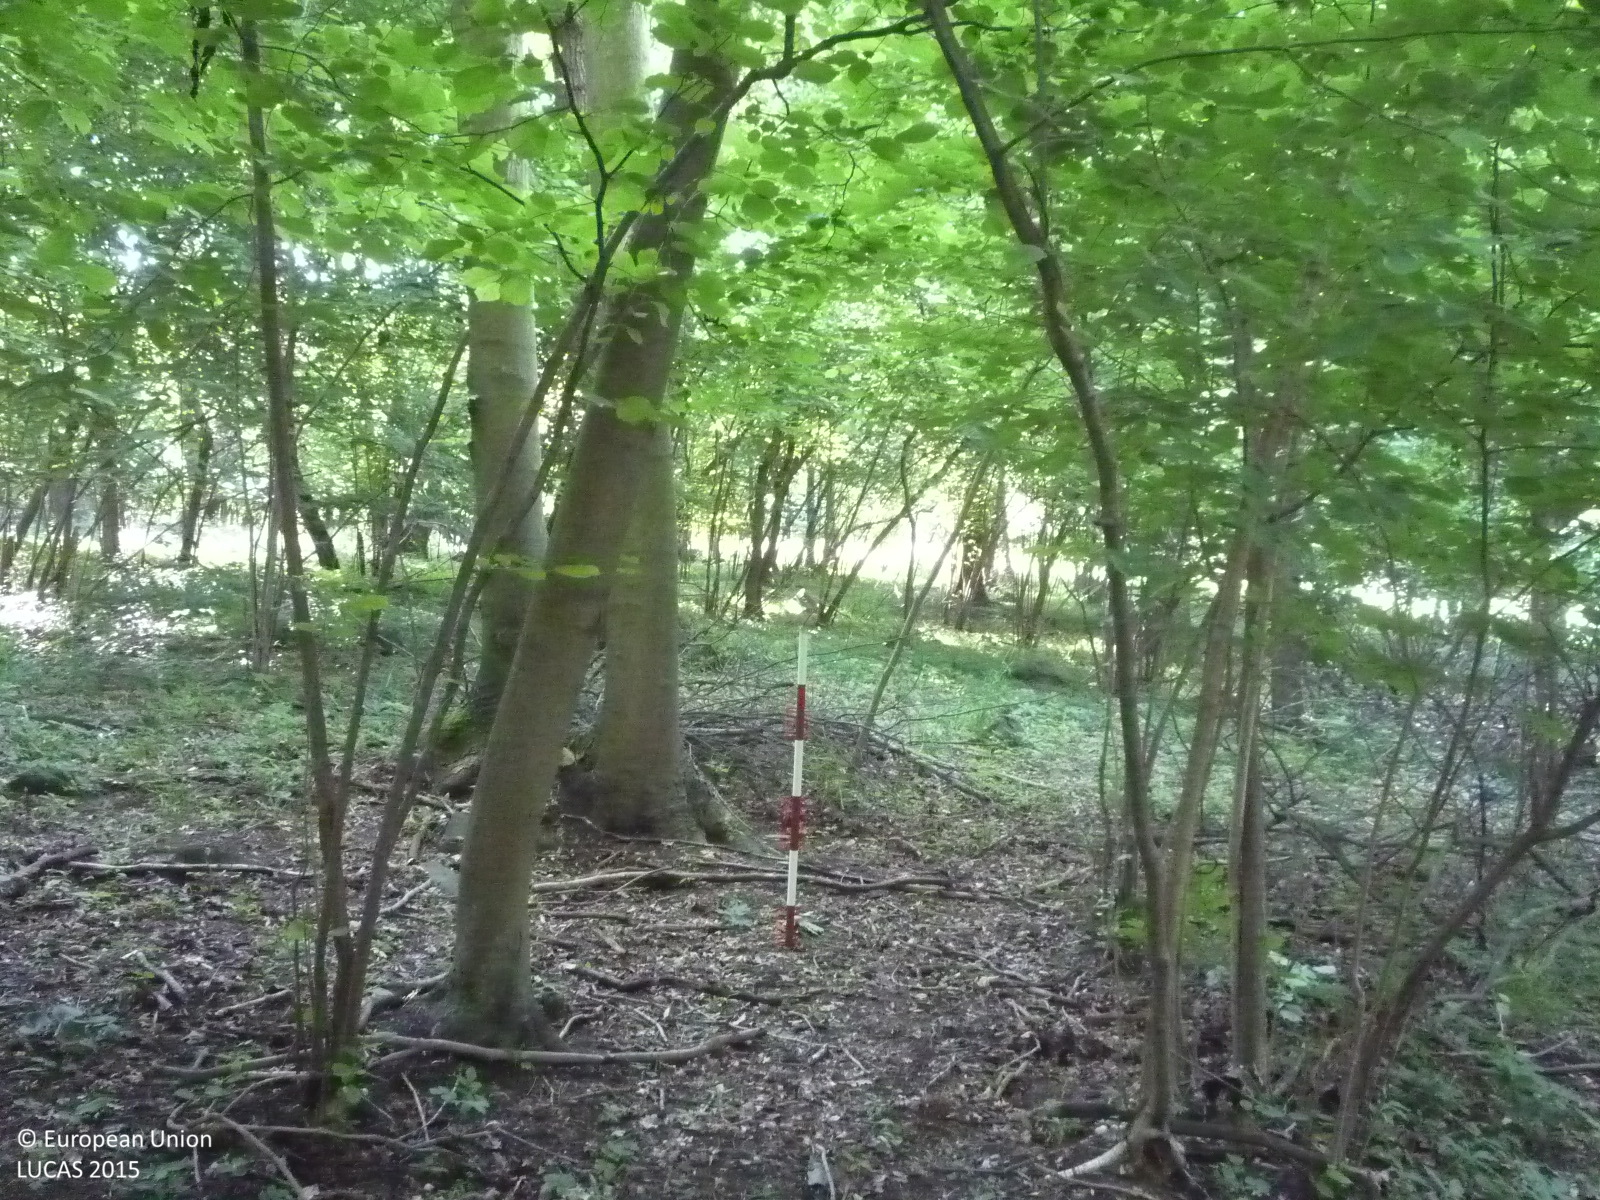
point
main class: Woodland
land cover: Broadleaved woodland
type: mesophytic deciduous forest
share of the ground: > 75 %
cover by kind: broadleaved forest trees 95 %, shrubs 5 %
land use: Forestry
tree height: > 5 m
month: July
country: CZ
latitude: 50.5323
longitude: 13.8805
